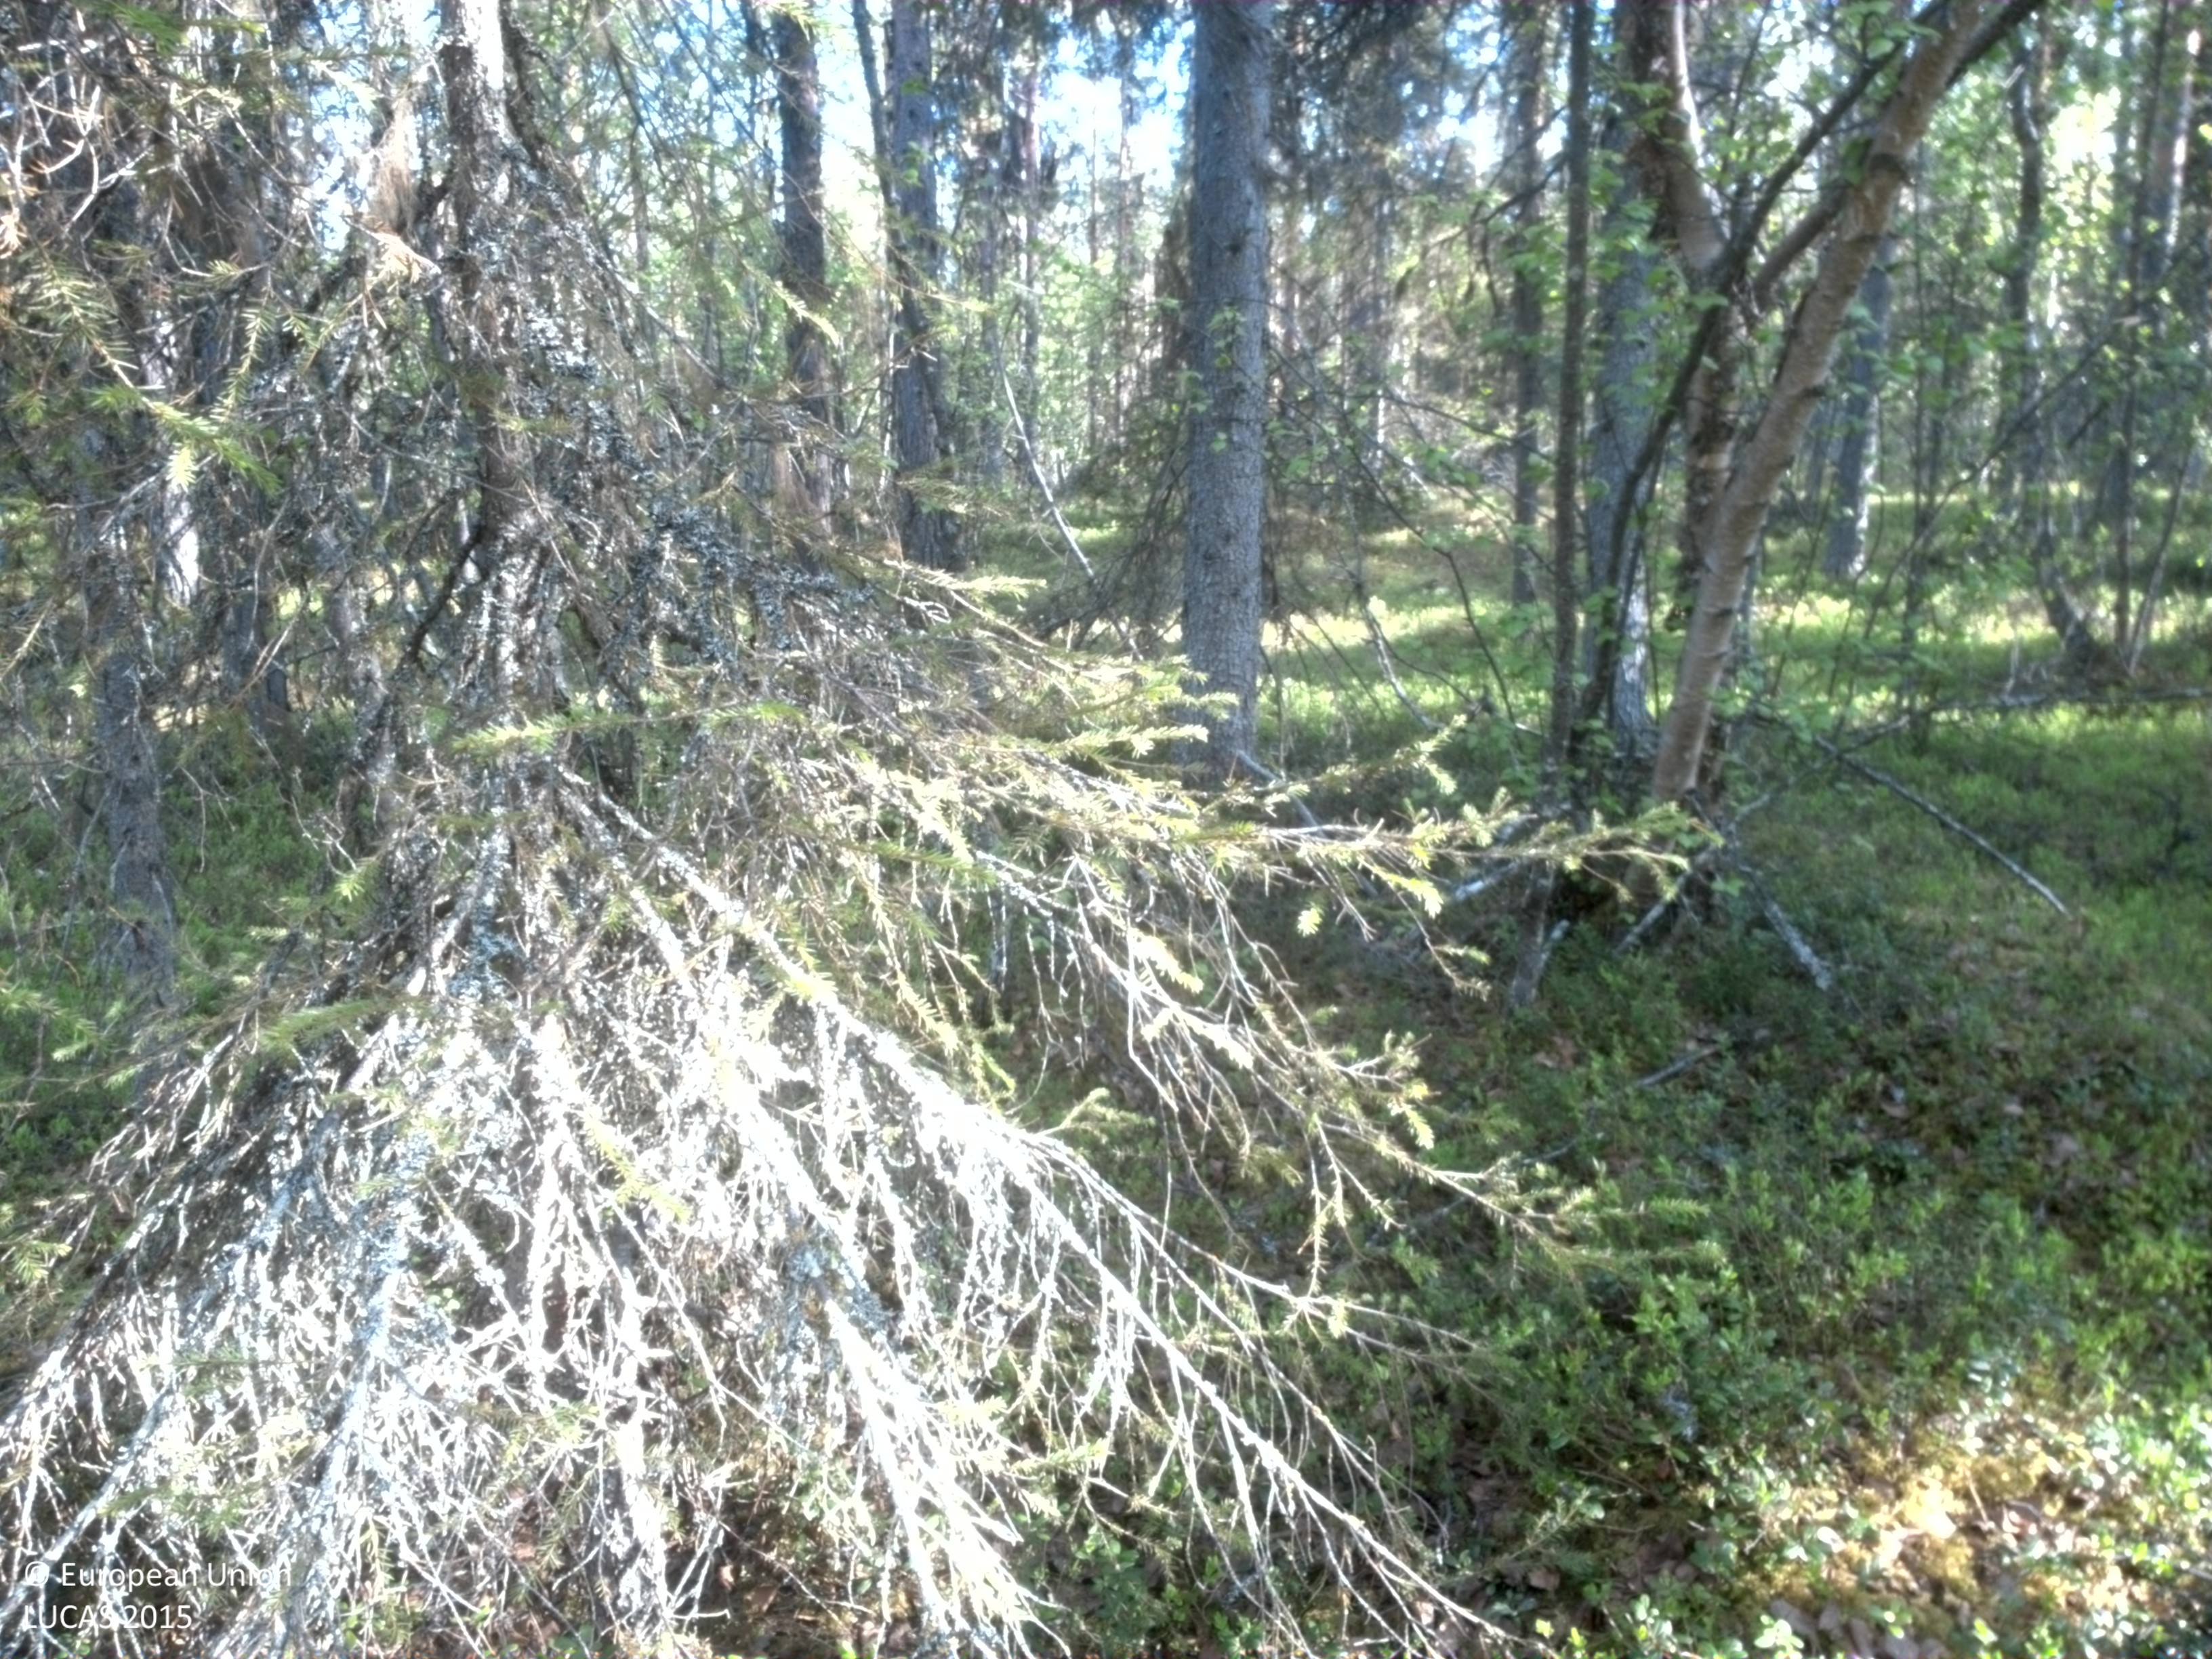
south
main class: Woodland
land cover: Other mixed woodland
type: boreal forest
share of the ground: 25 - 50 %
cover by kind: shrubs 50 %, coniferous forest trees 30 %, broadleaved forest trees 15 %, lichens and mosses 5 %
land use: Forestry
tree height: > 5 m
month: June
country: SE
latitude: 67.0696
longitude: 21.2931
